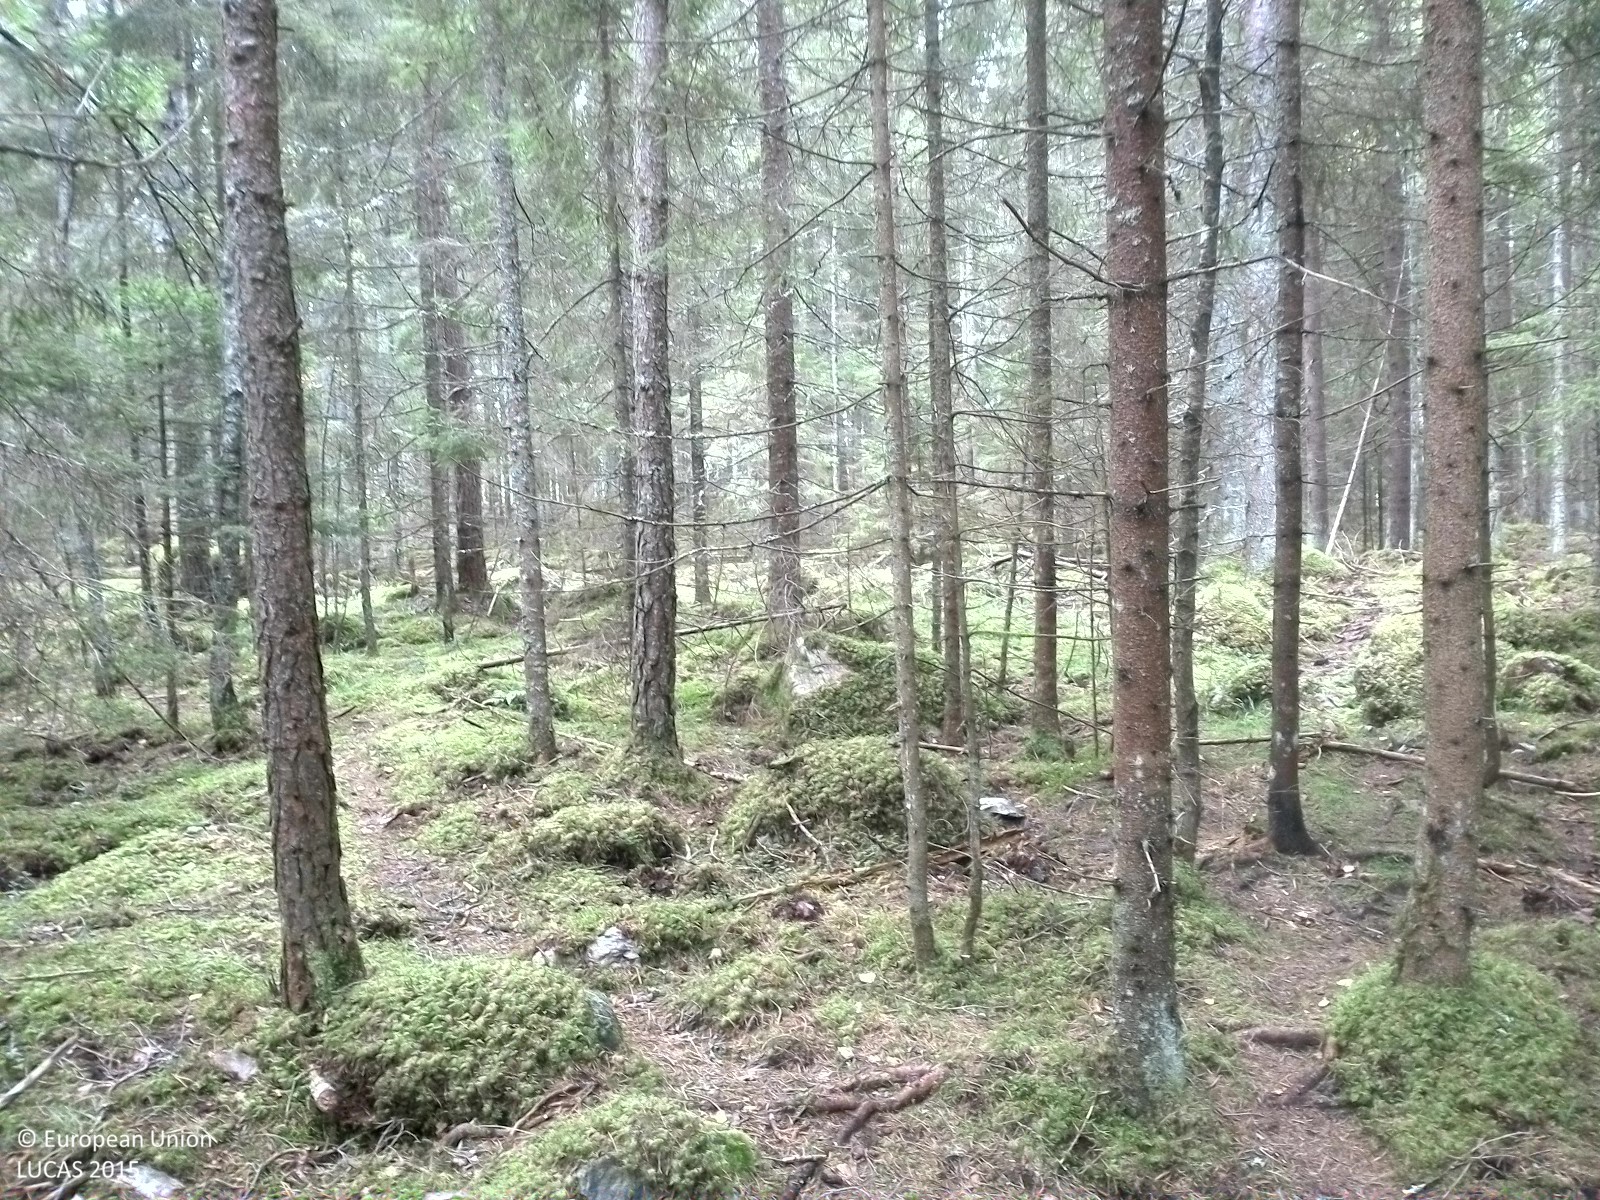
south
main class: Woodland
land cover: Spruce dominated coniferous woodland
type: boreal forest
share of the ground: 50 - 75 %
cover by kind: coniferous forest trees 60 %, lichens and mosses 30 %, herbaceous plants 5 %, unconsolidated bare surface 5 %
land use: Forestry
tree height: > 5 m
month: August
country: SE
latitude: 58.7876
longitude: 15.6163
